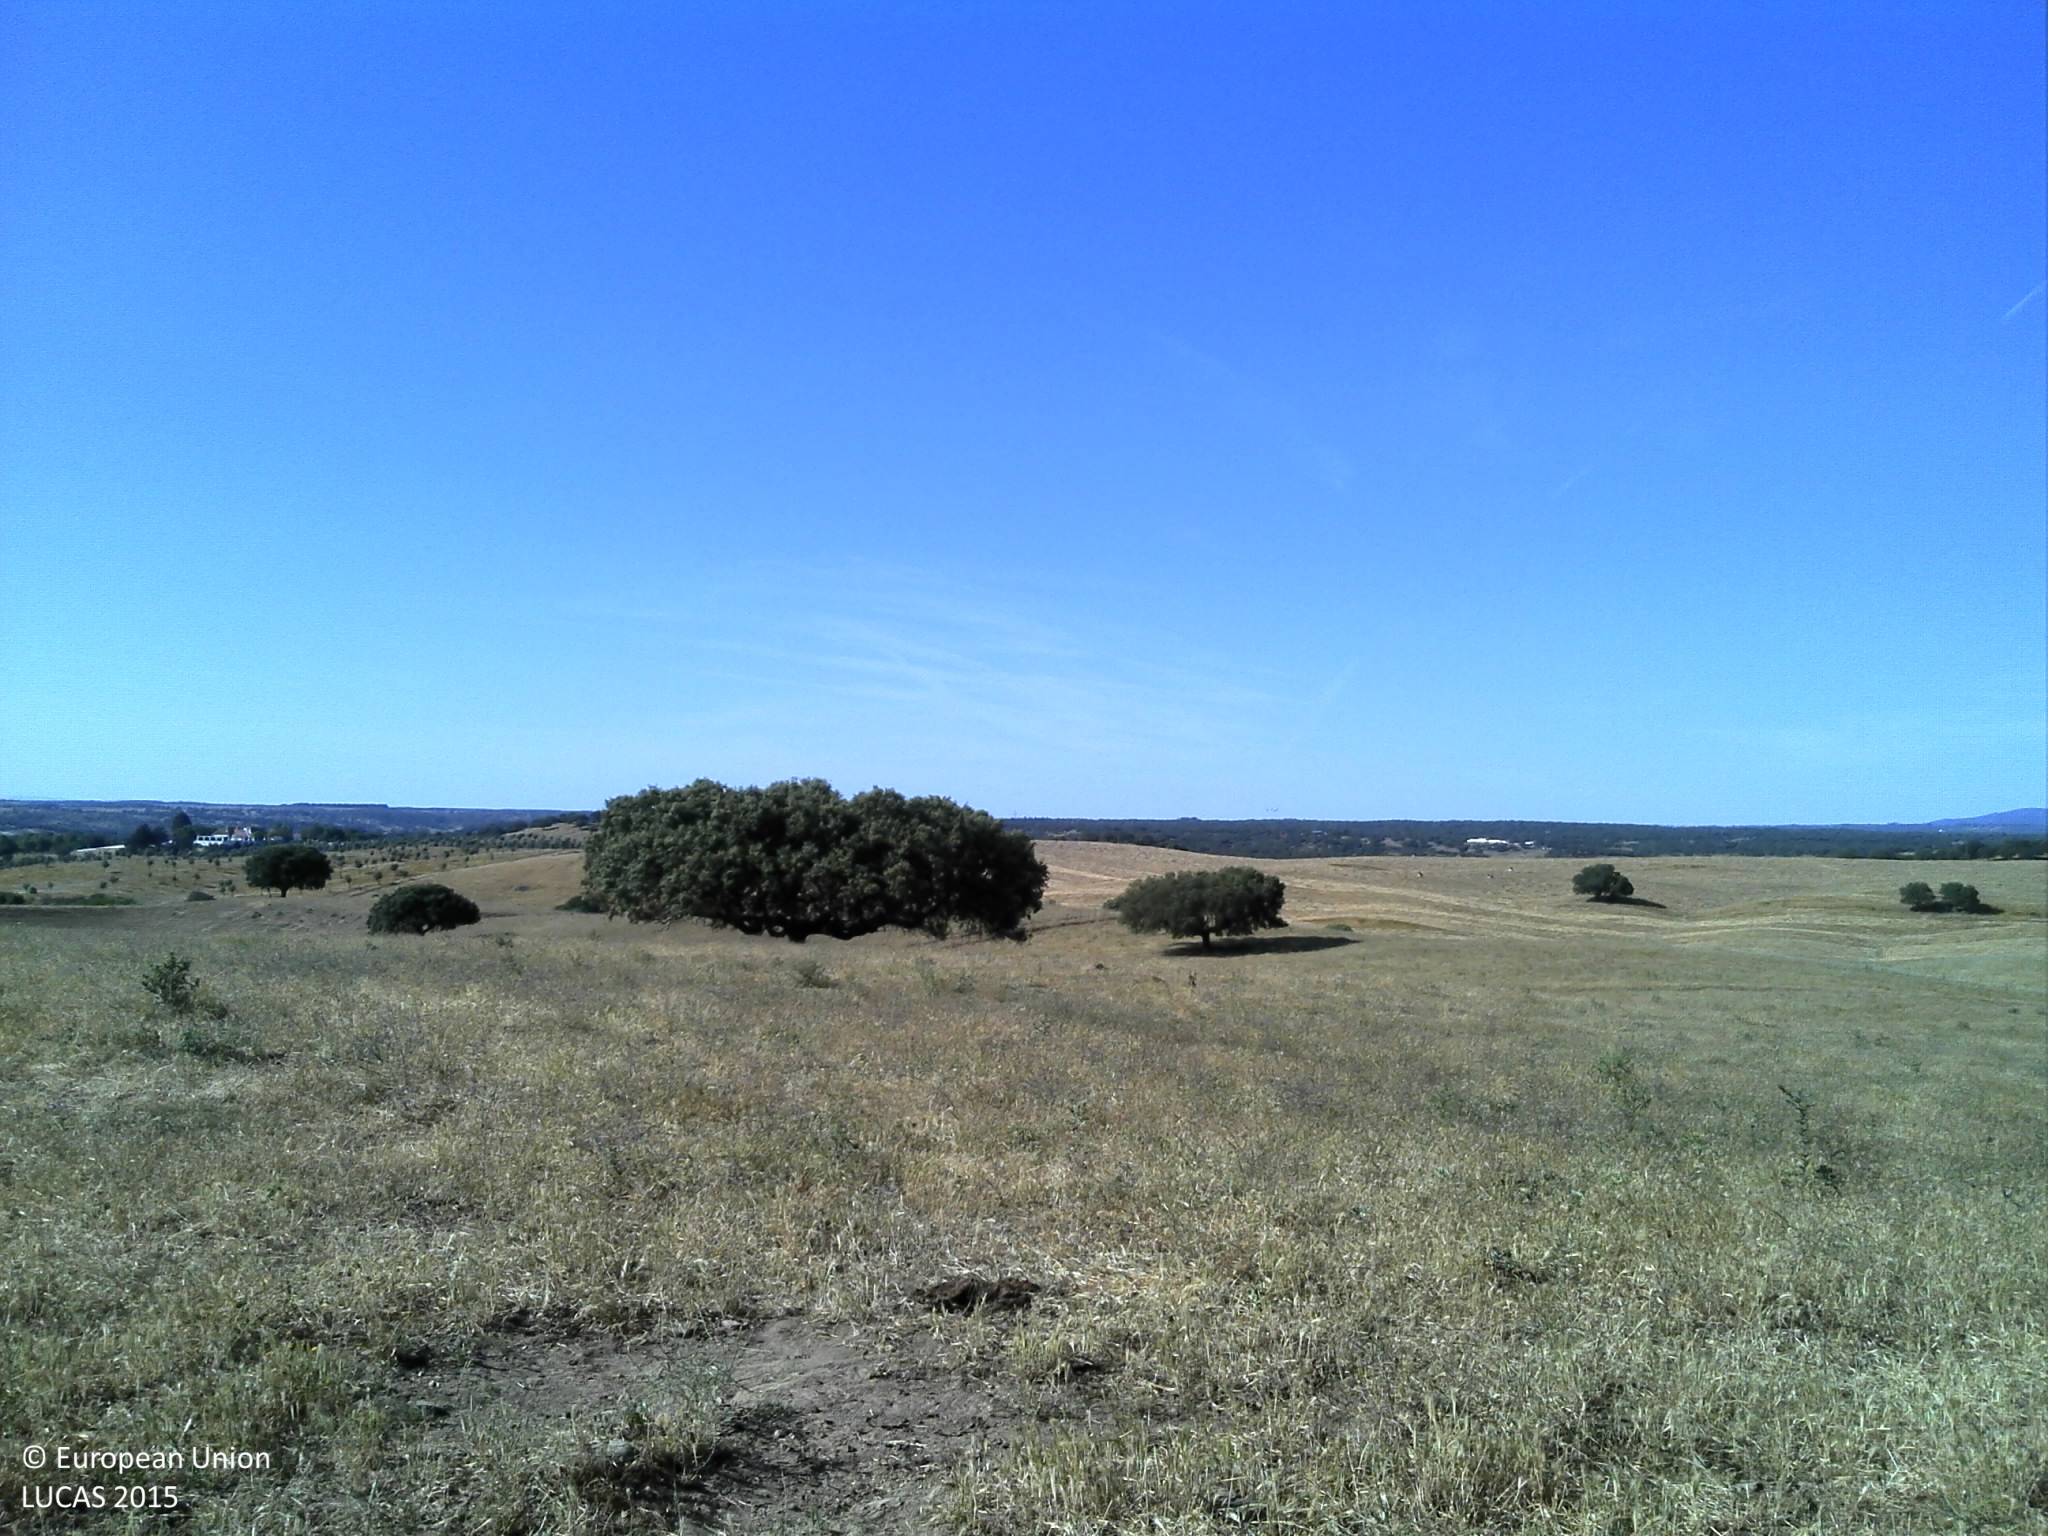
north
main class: Grassland
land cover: Grassland with sparse tree/shrub cover
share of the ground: 50 - 75 %
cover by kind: herbaceous plants 75 %, unconsolidated bare surface 20 %, broadleaved forest trees 5 %
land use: Agriculture (excluding fallow land and kitchen gardens)
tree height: > 5 m
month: May
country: PT
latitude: 39.2529
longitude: -7.6007
